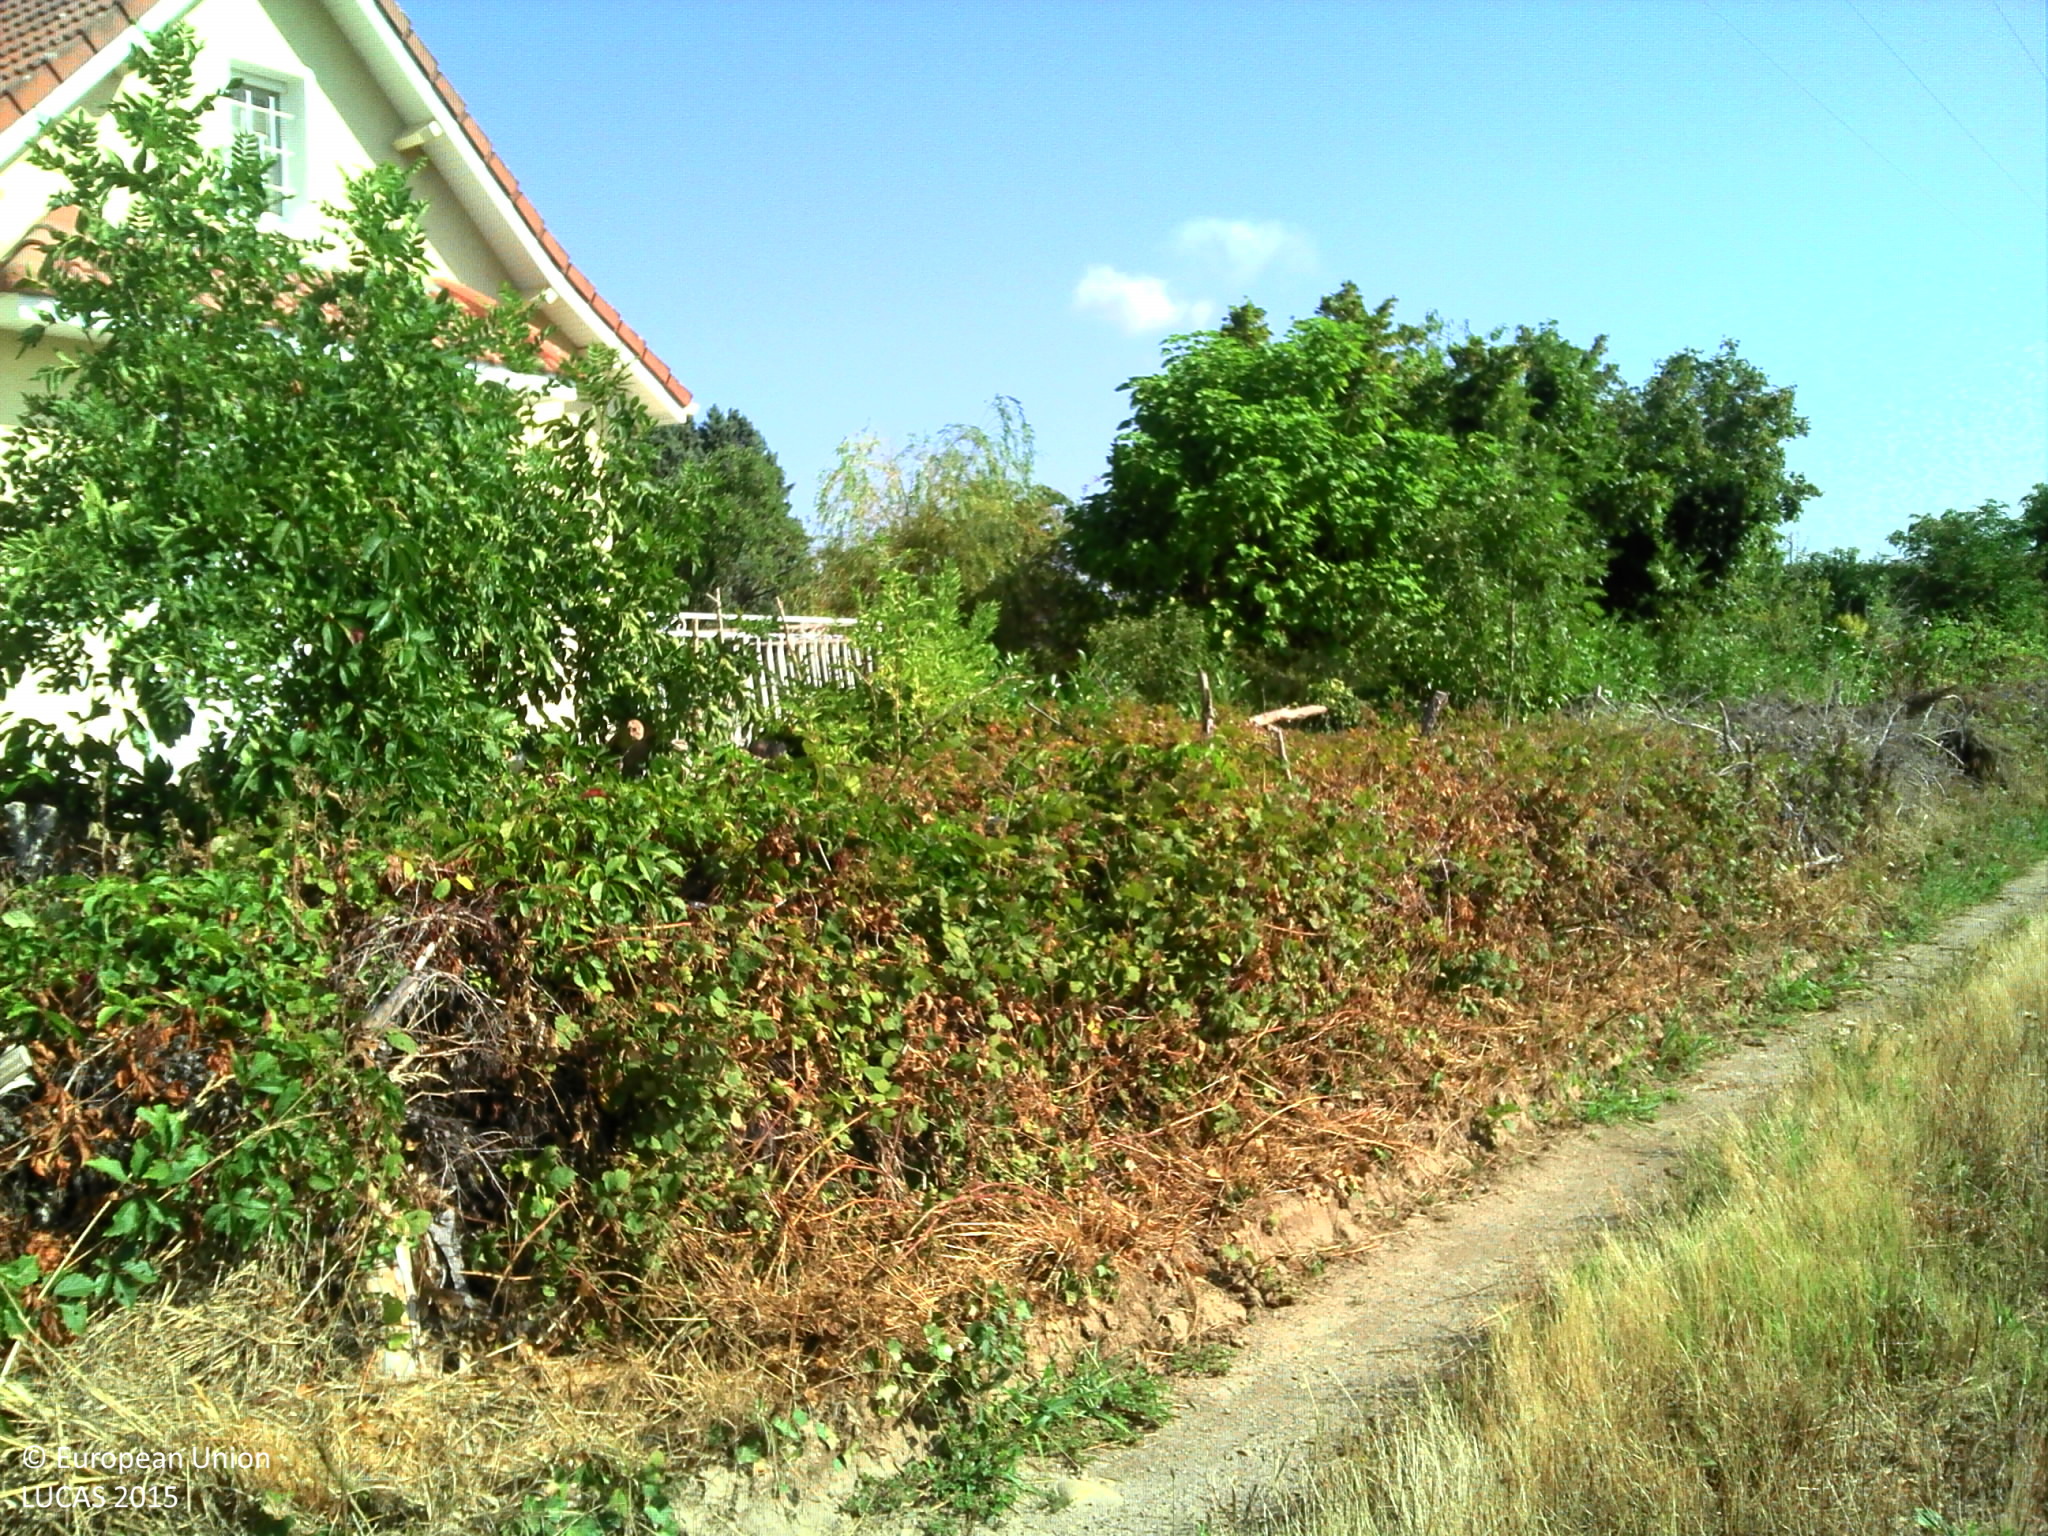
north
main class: Cropland
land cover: Sunflower
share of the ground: > 75 %
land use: Agriculture (excluding fallow land and kitchen gardens)
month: July
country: FR
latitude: 45.5099
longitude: 4.9483
